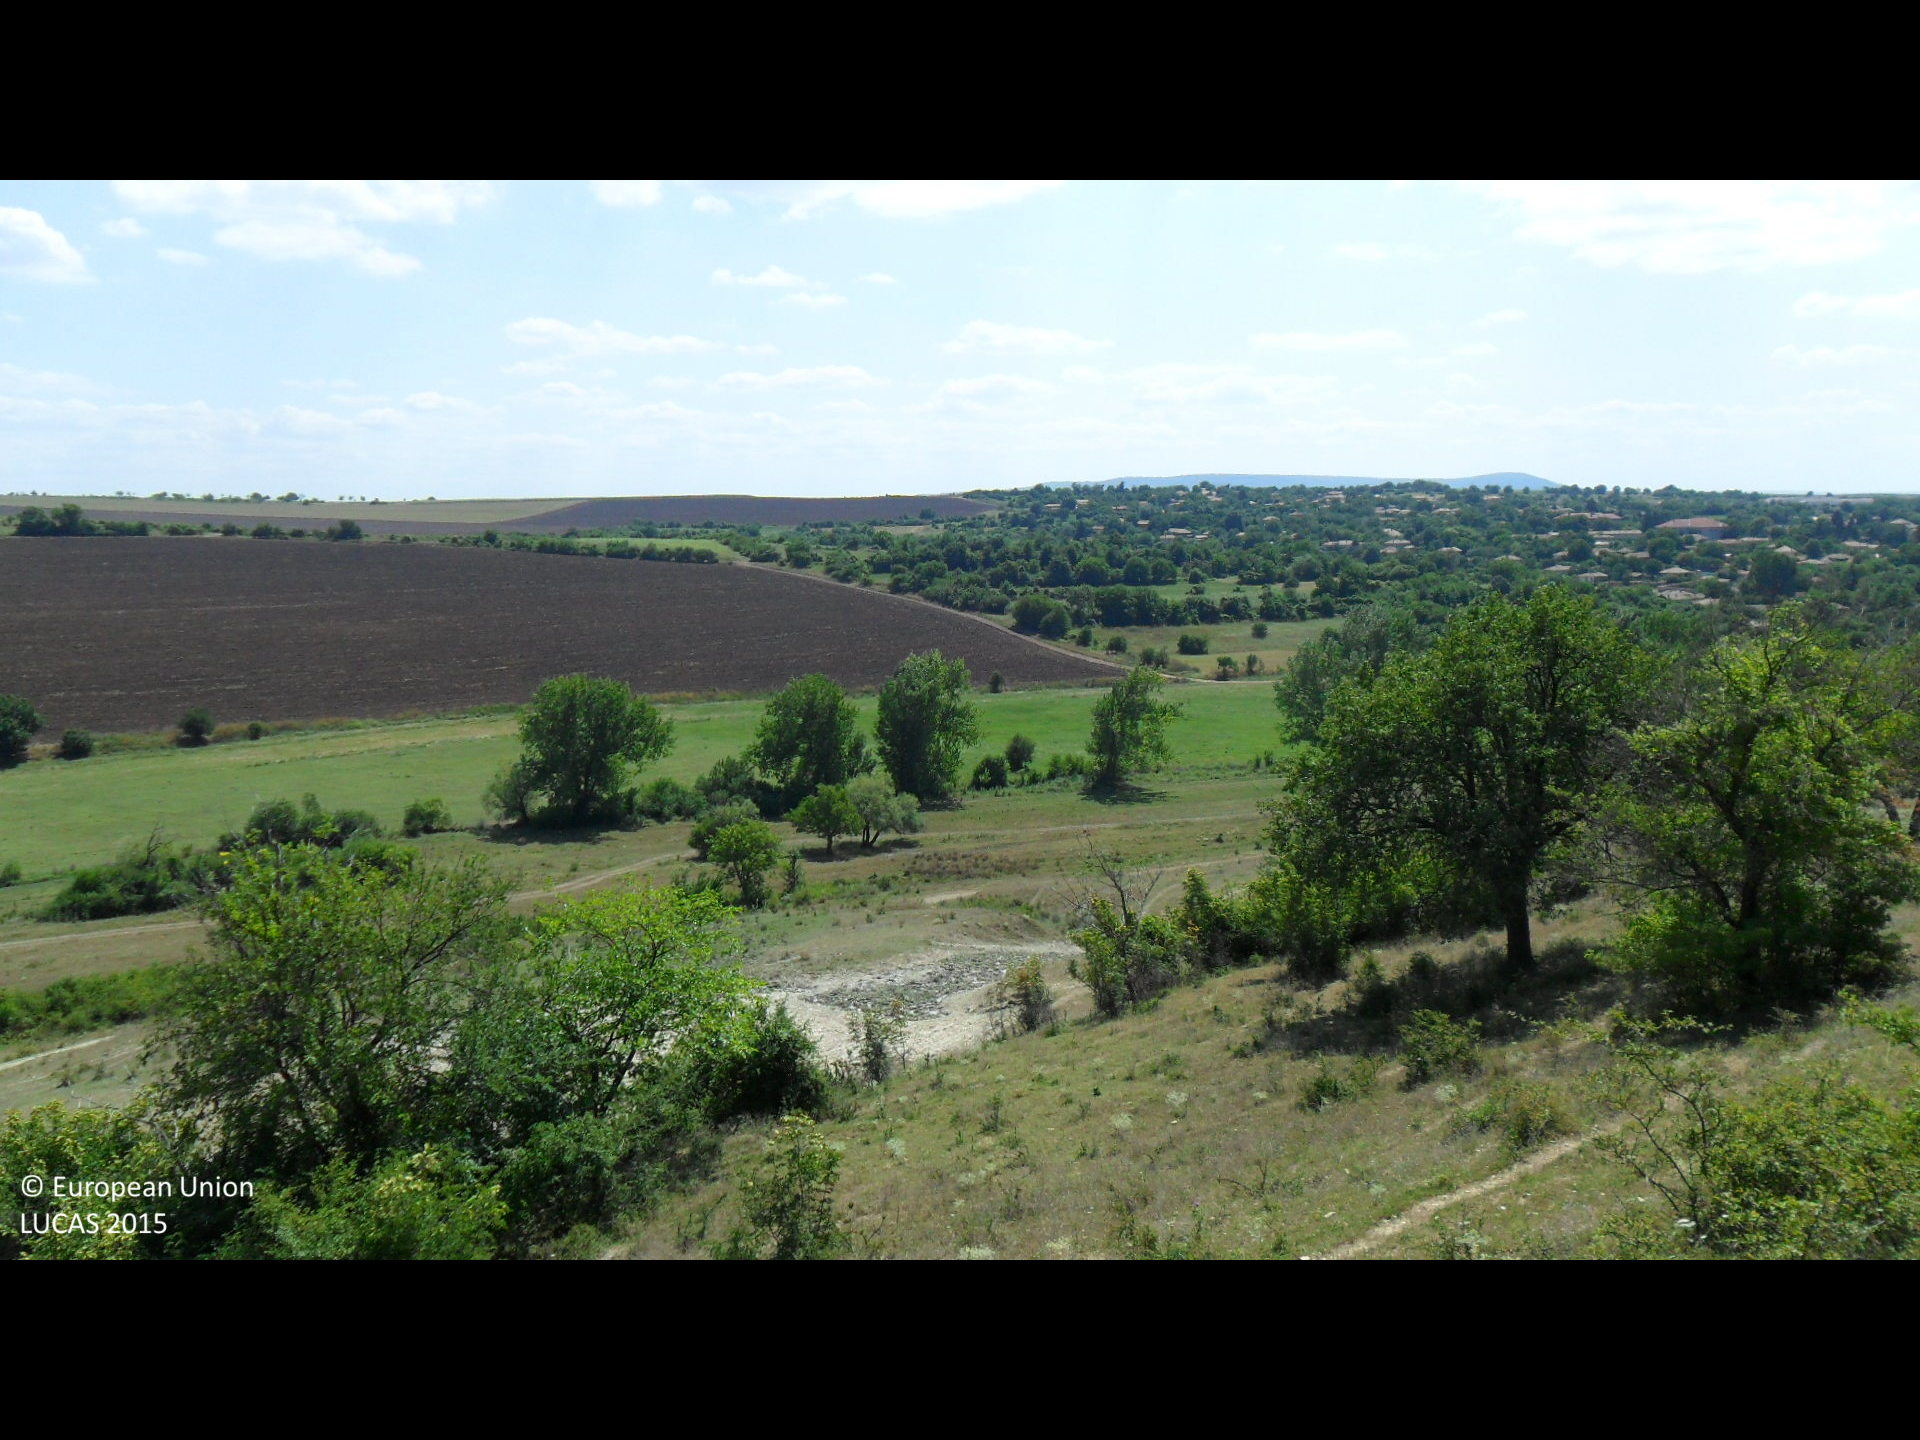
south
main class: Grassland
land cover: Grassland with sparse tree/shrub cover
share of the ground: > 75 %
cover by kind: herbaceous plants 90 %, broadleaved forest trees 5 %, shrubs 5 %
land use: Agriculture (excluding fallow land and kitchen gardens)
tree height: < 5 m
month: August
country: BG
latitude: 43.4357
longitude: 26.4221
